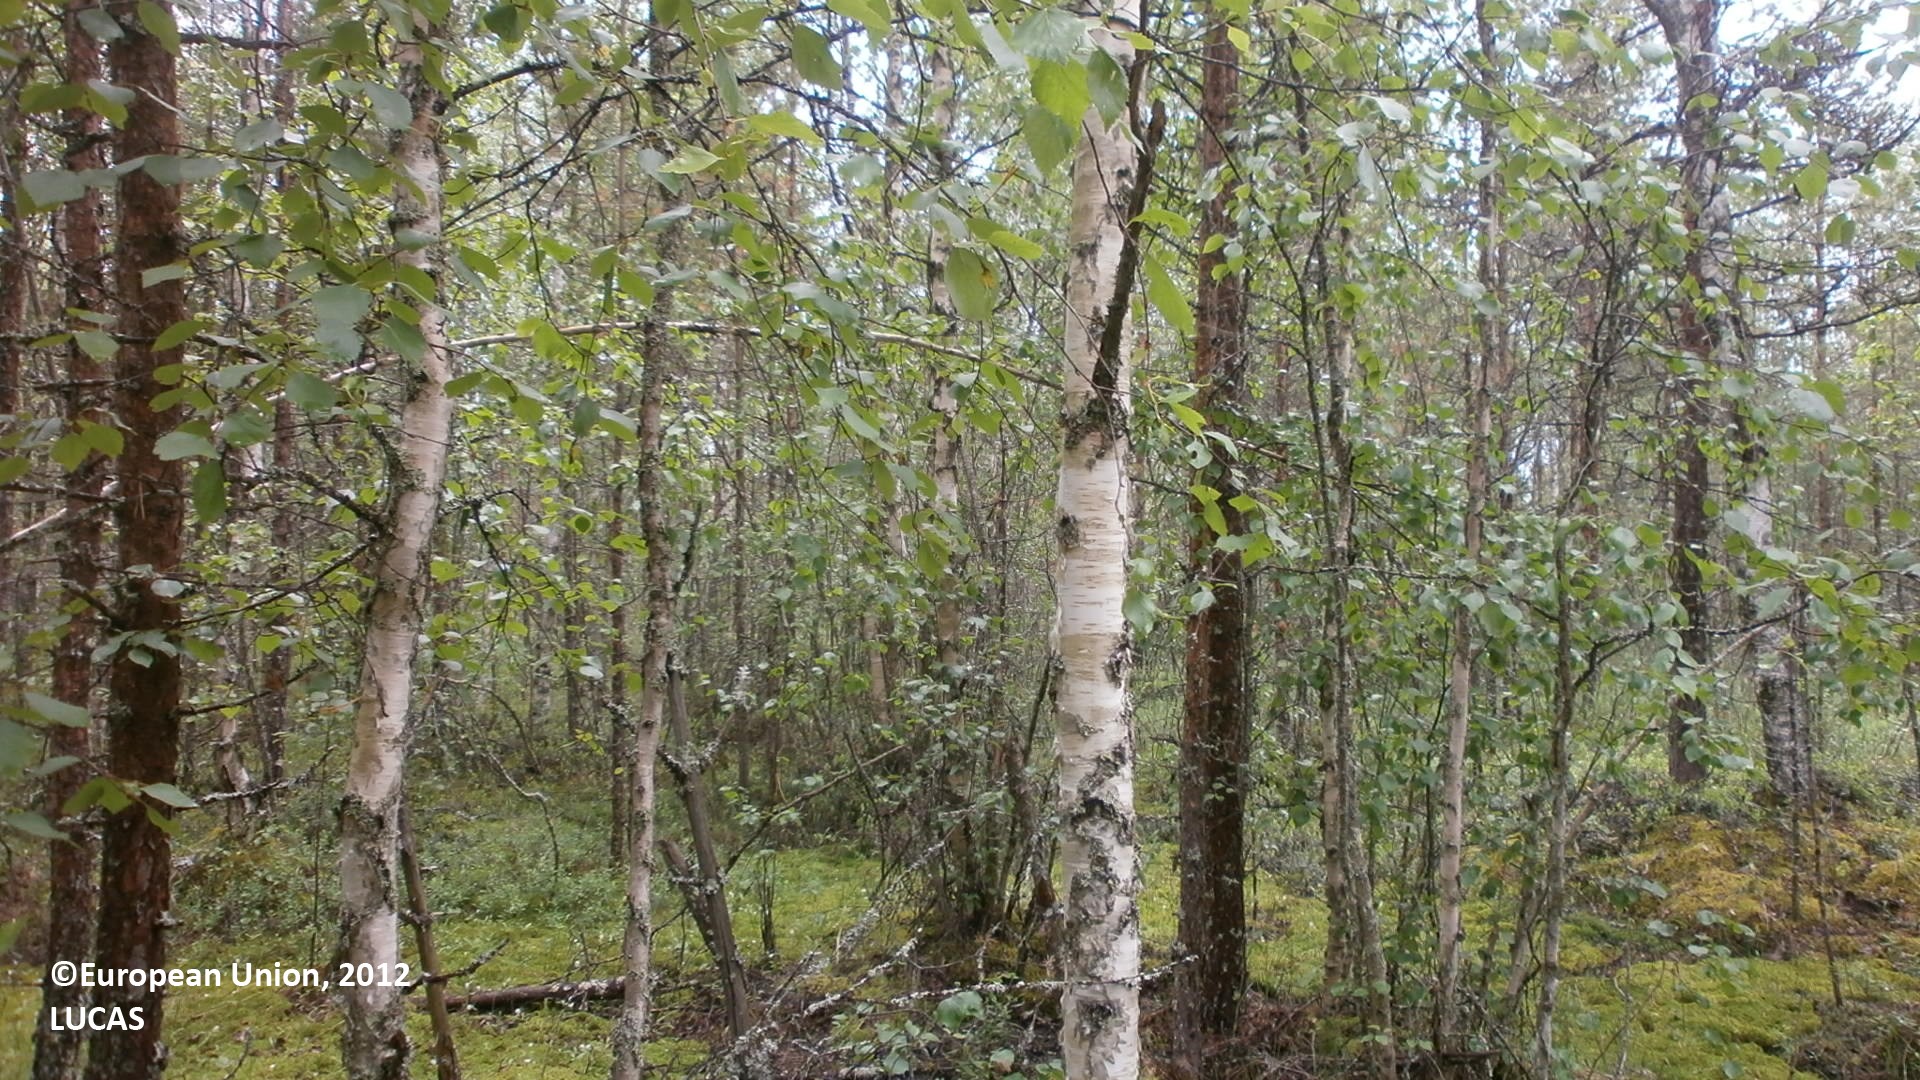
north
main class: Woodland
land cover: Pine dominated mixed woodland
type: mire and swamp forests
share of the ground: 50 - 75 %
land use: Forestry
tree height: > 5 m
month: June
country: FI
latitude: 64.5618
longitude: 25.0398
